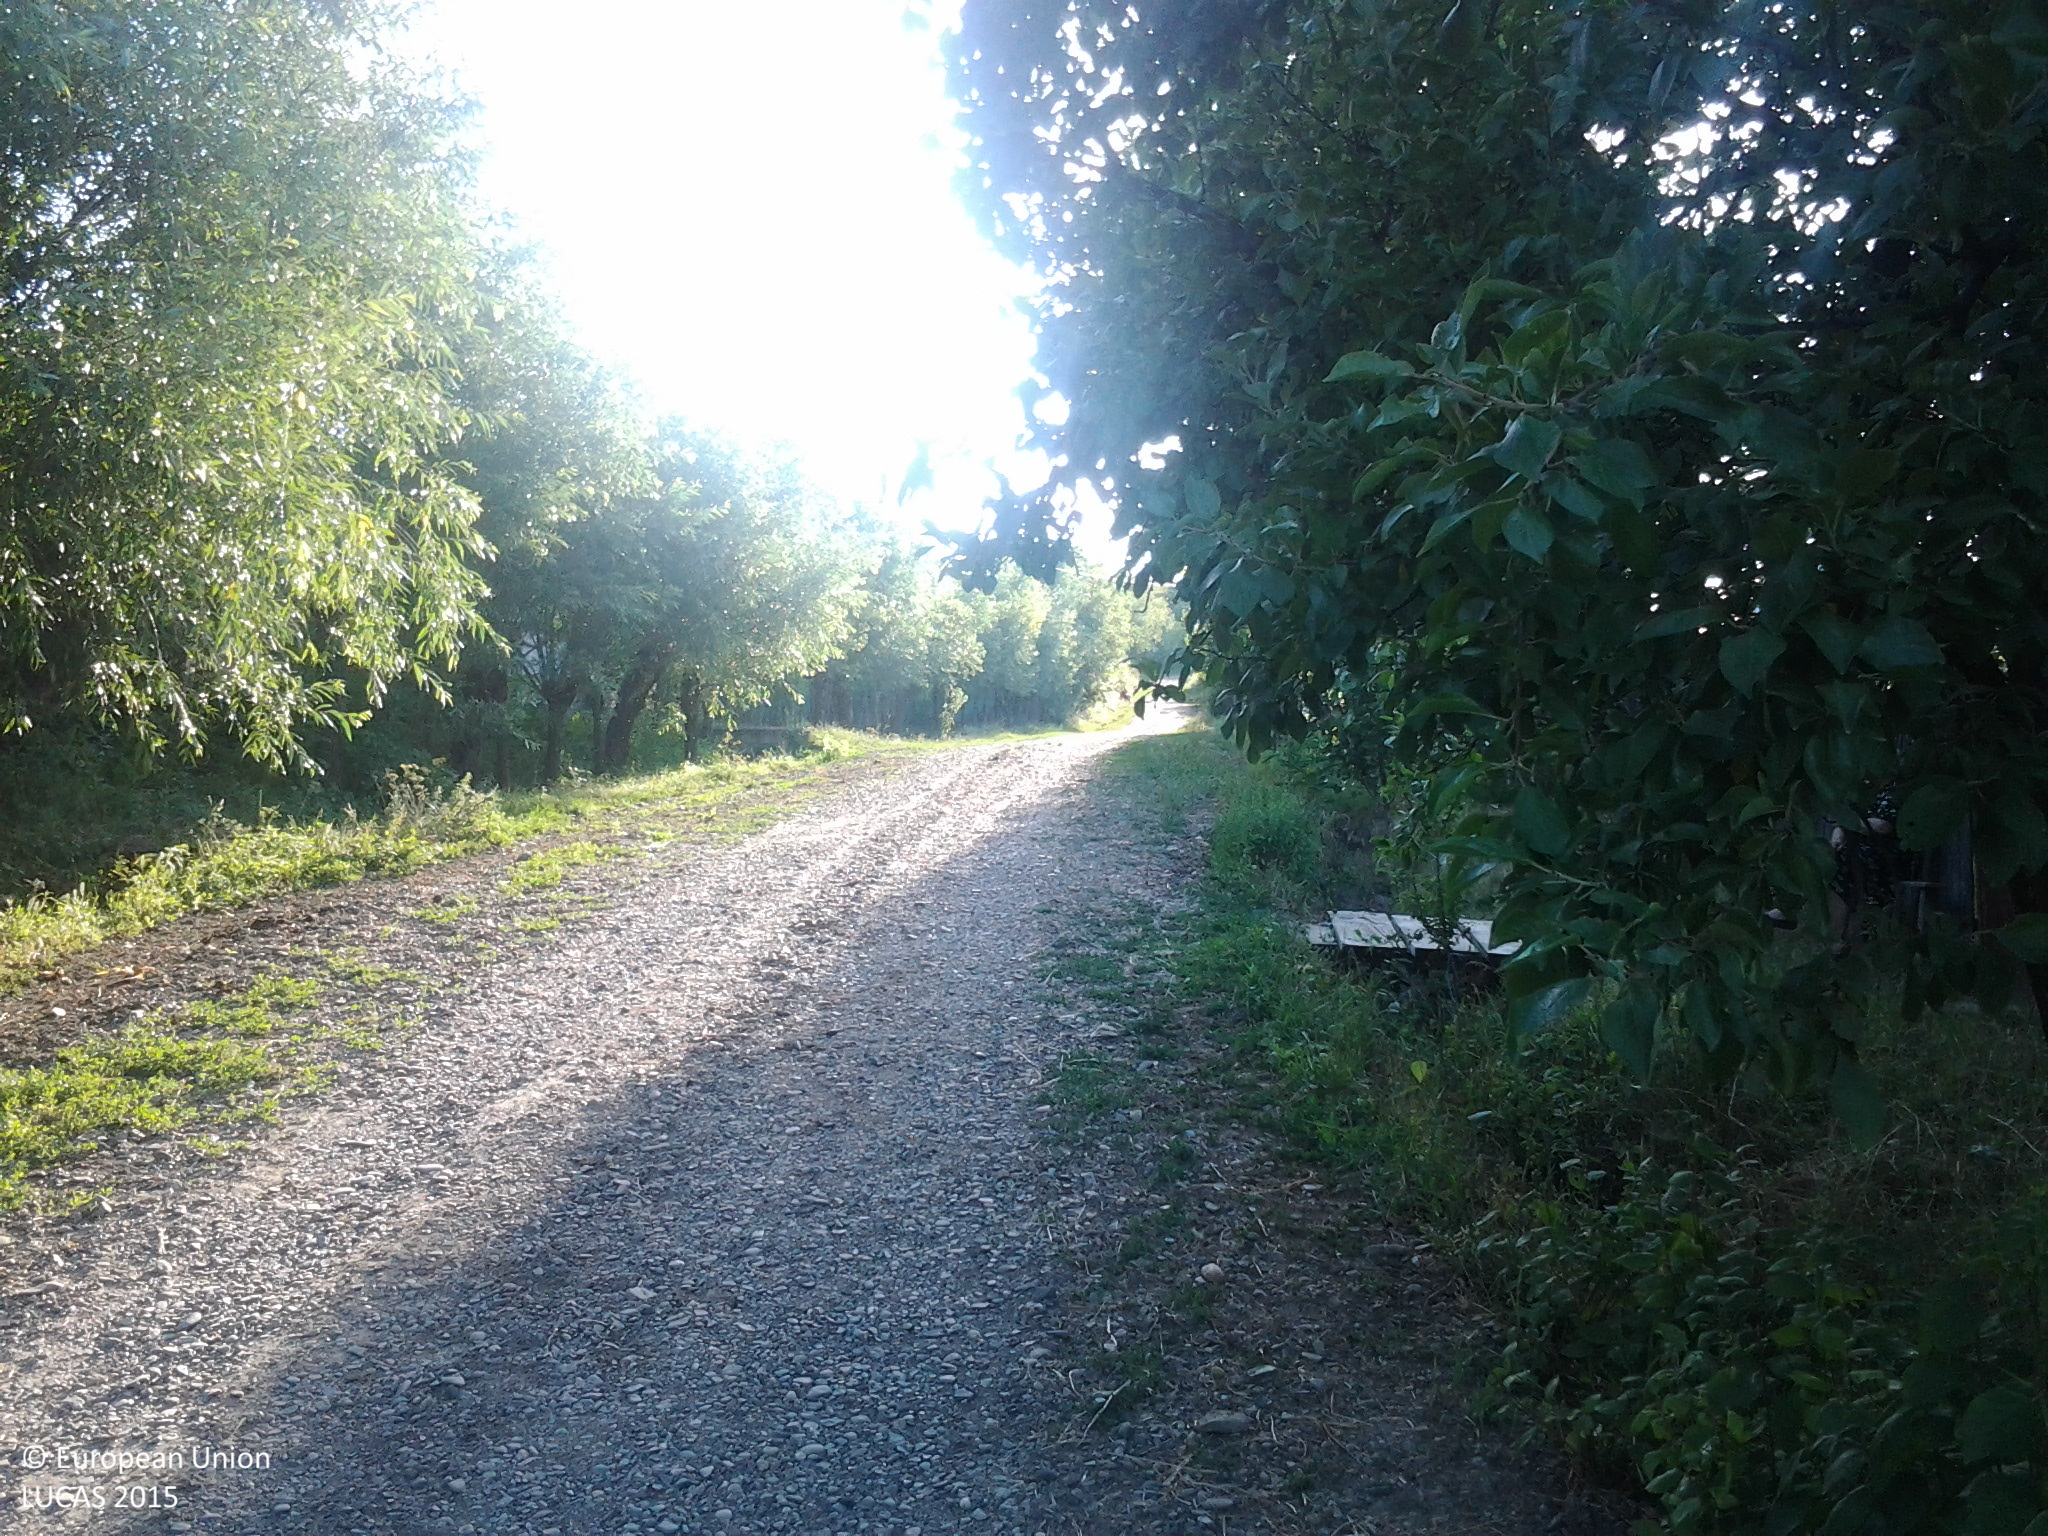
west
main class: Grassland
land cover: Grassland with sparse tree/shrub cover
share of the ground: > 75 %
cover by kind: herbaceous plants 90 %, broadleaved forest trees 5 %, shrubs 5 %
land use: Agriculture (excluding fallow land and kitchen gardens)
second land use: Residential
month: June
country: RO
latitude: 47.1998
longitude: 26.9022
